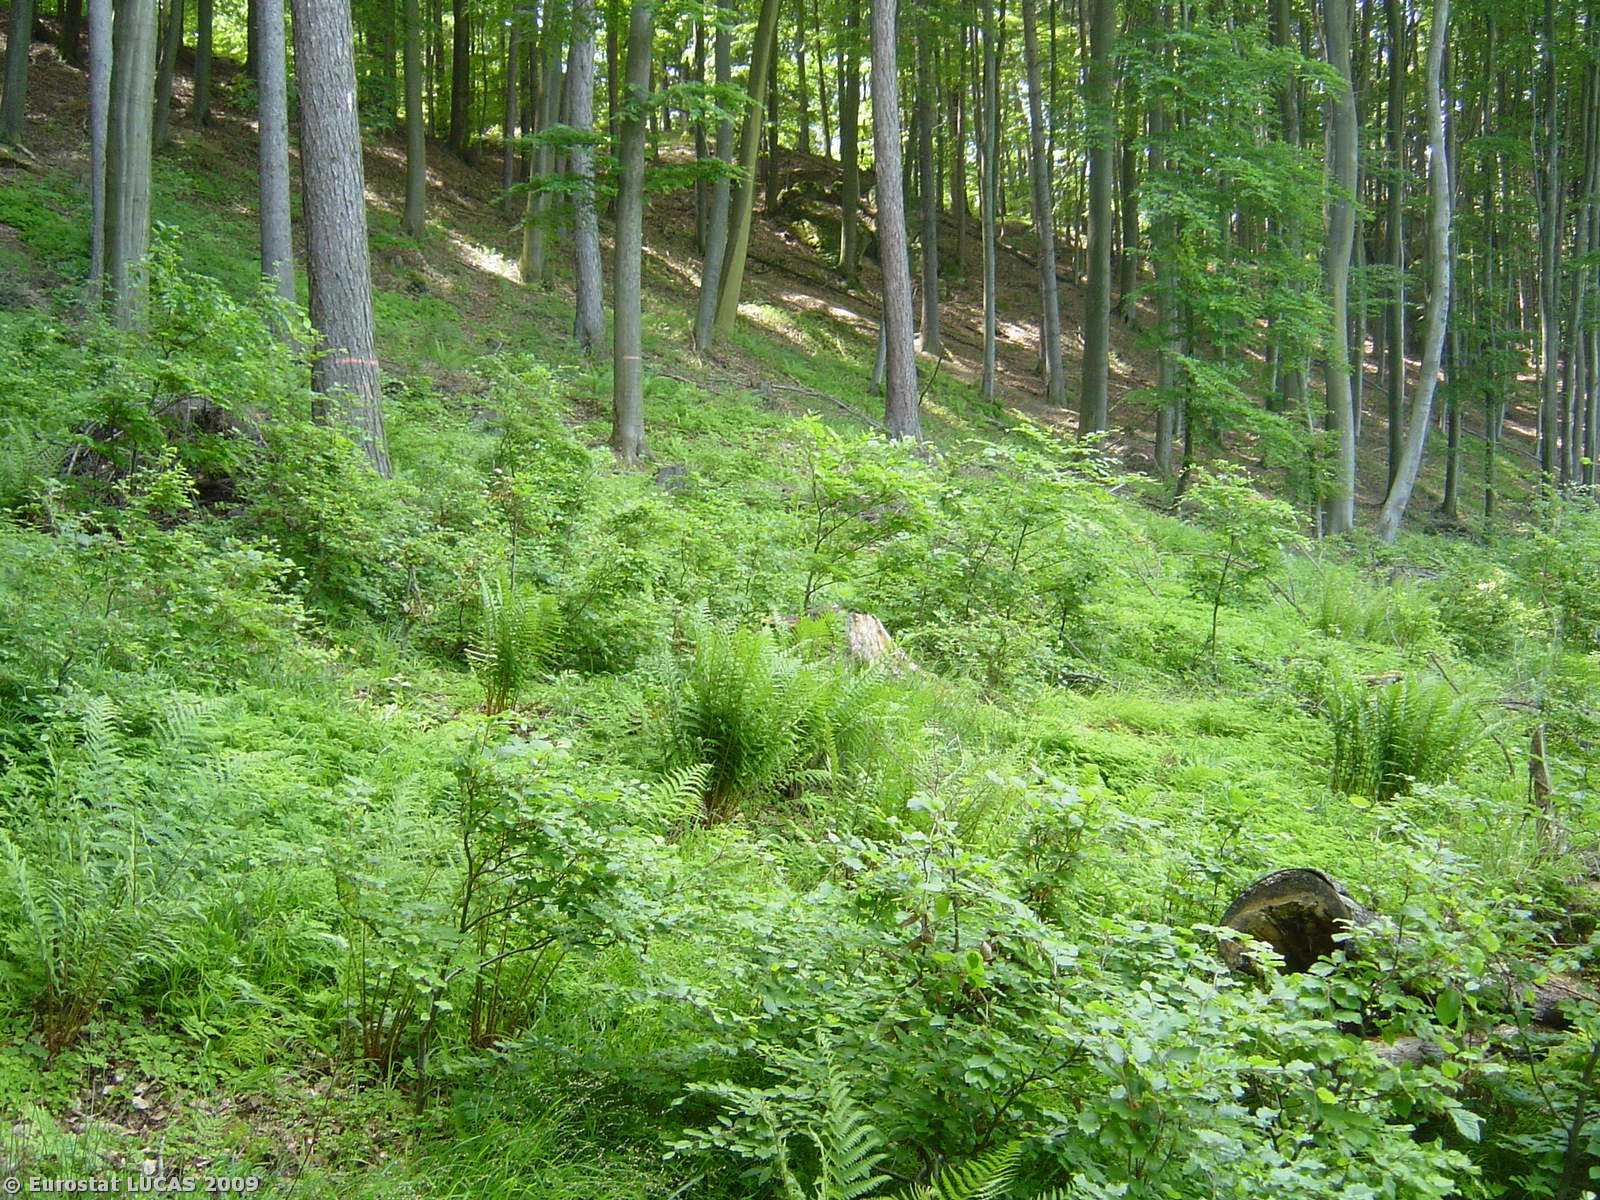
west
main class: Woodland
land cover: Mixed woodland
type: hemiboreal forest and nemoral coniferous forest and mixed broadleaved-coniferous forest
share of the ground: 50 - 75 %
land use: Forestry
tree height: > 5 m
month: May
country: CZ
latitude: 49.1060
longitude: 17.2290
